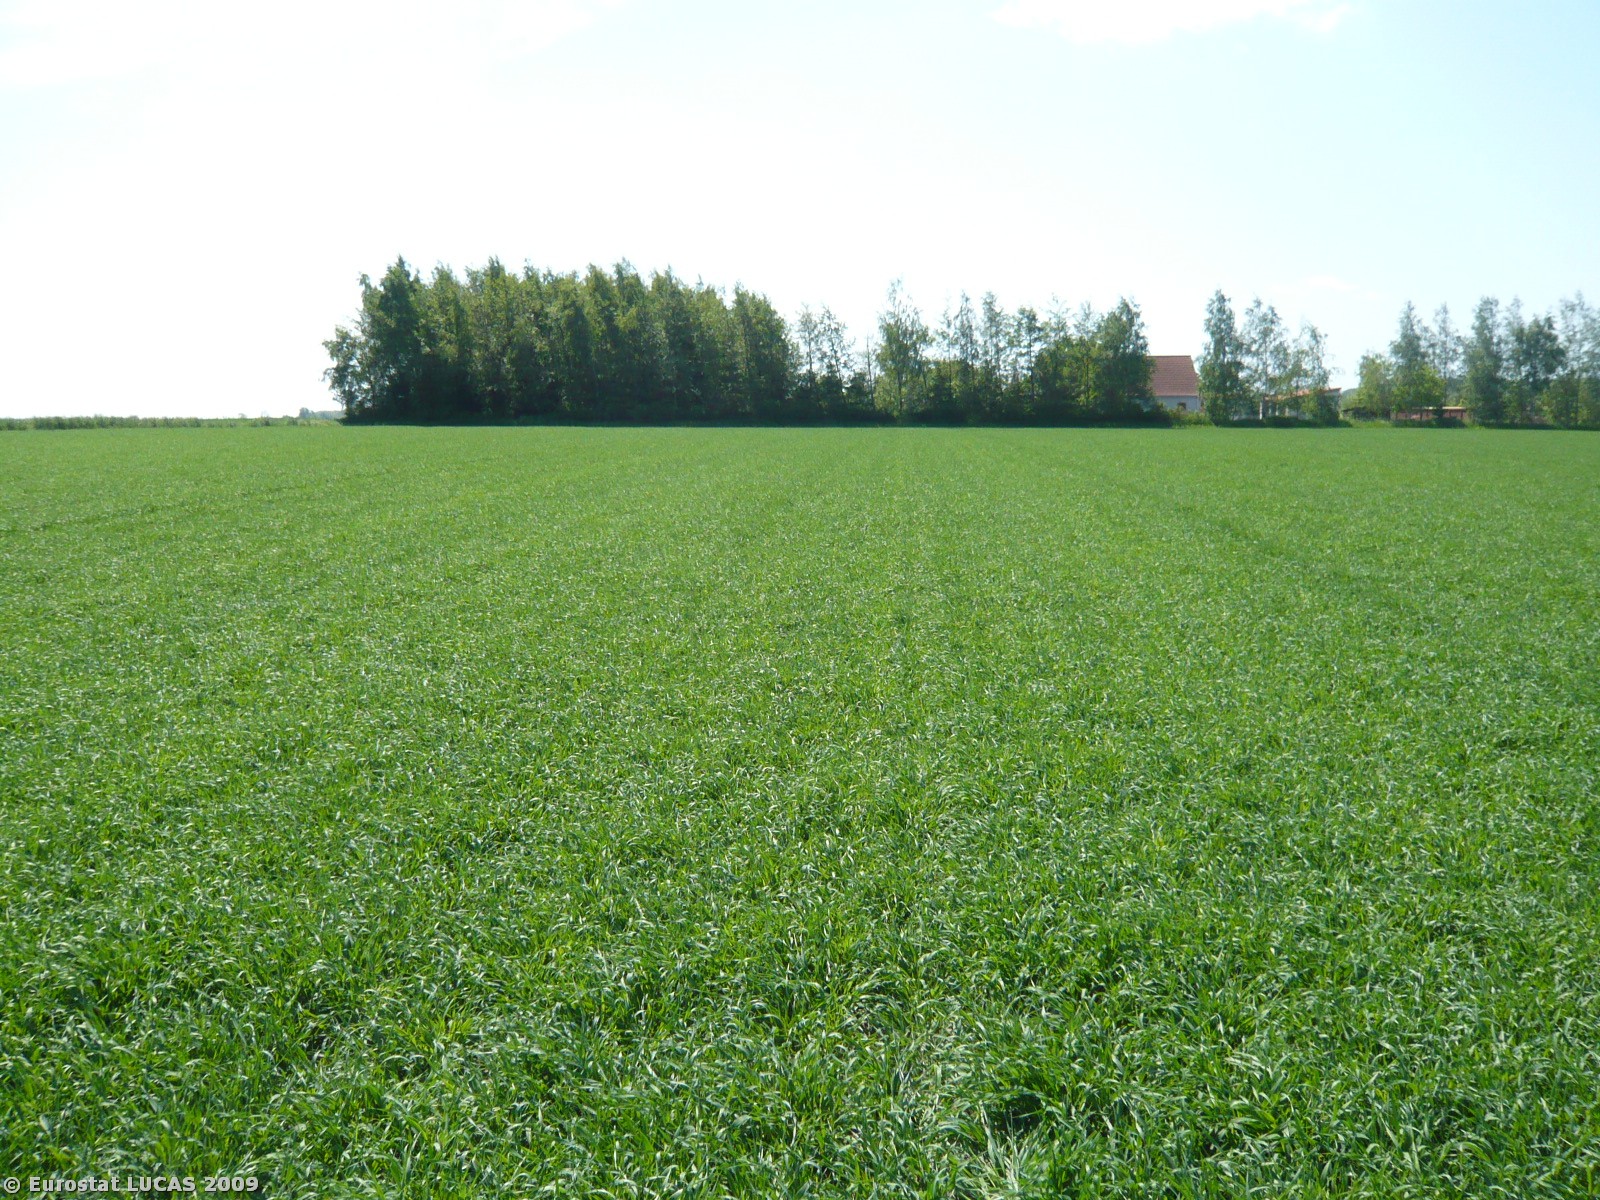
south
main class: Cropland
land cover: Barley
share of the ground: > 75 %
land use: Agriculture (excluding fallow land and kitchen gardens)
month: May
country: DK
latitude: 55.3475
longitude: 11.8436
